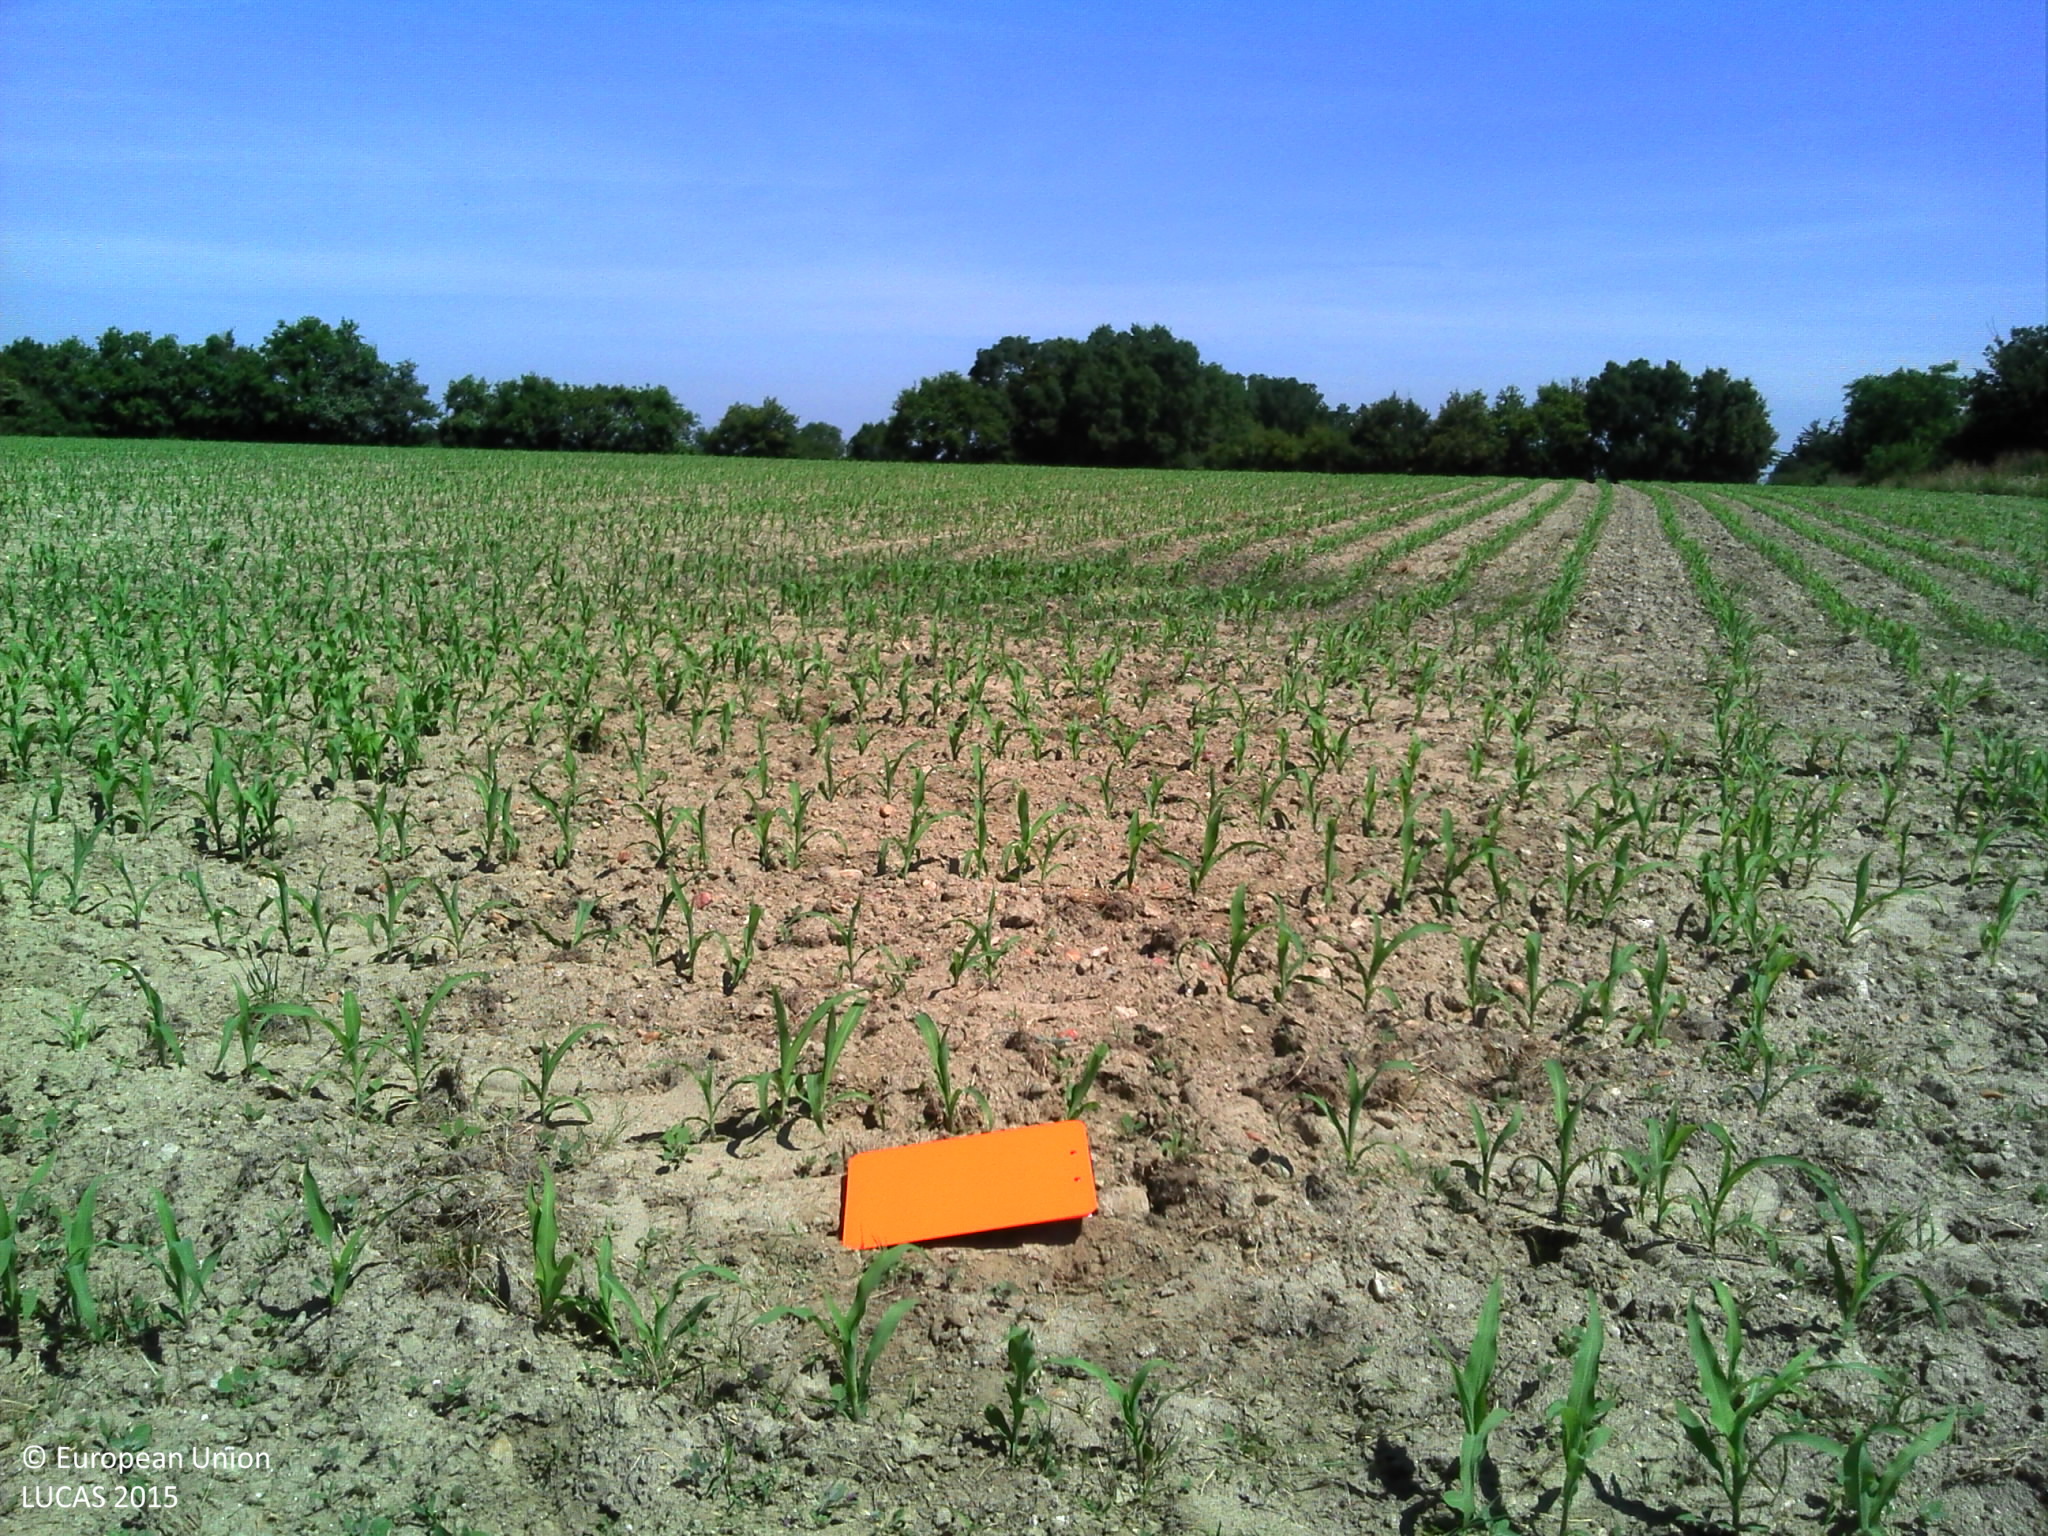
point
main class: Cropland
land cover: Maize
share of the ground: 10 - 25 %
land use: Agriculture (excluding fallow land and kitchen gardens)
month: June
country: FR
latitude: 46.9504
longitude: -1.8035
